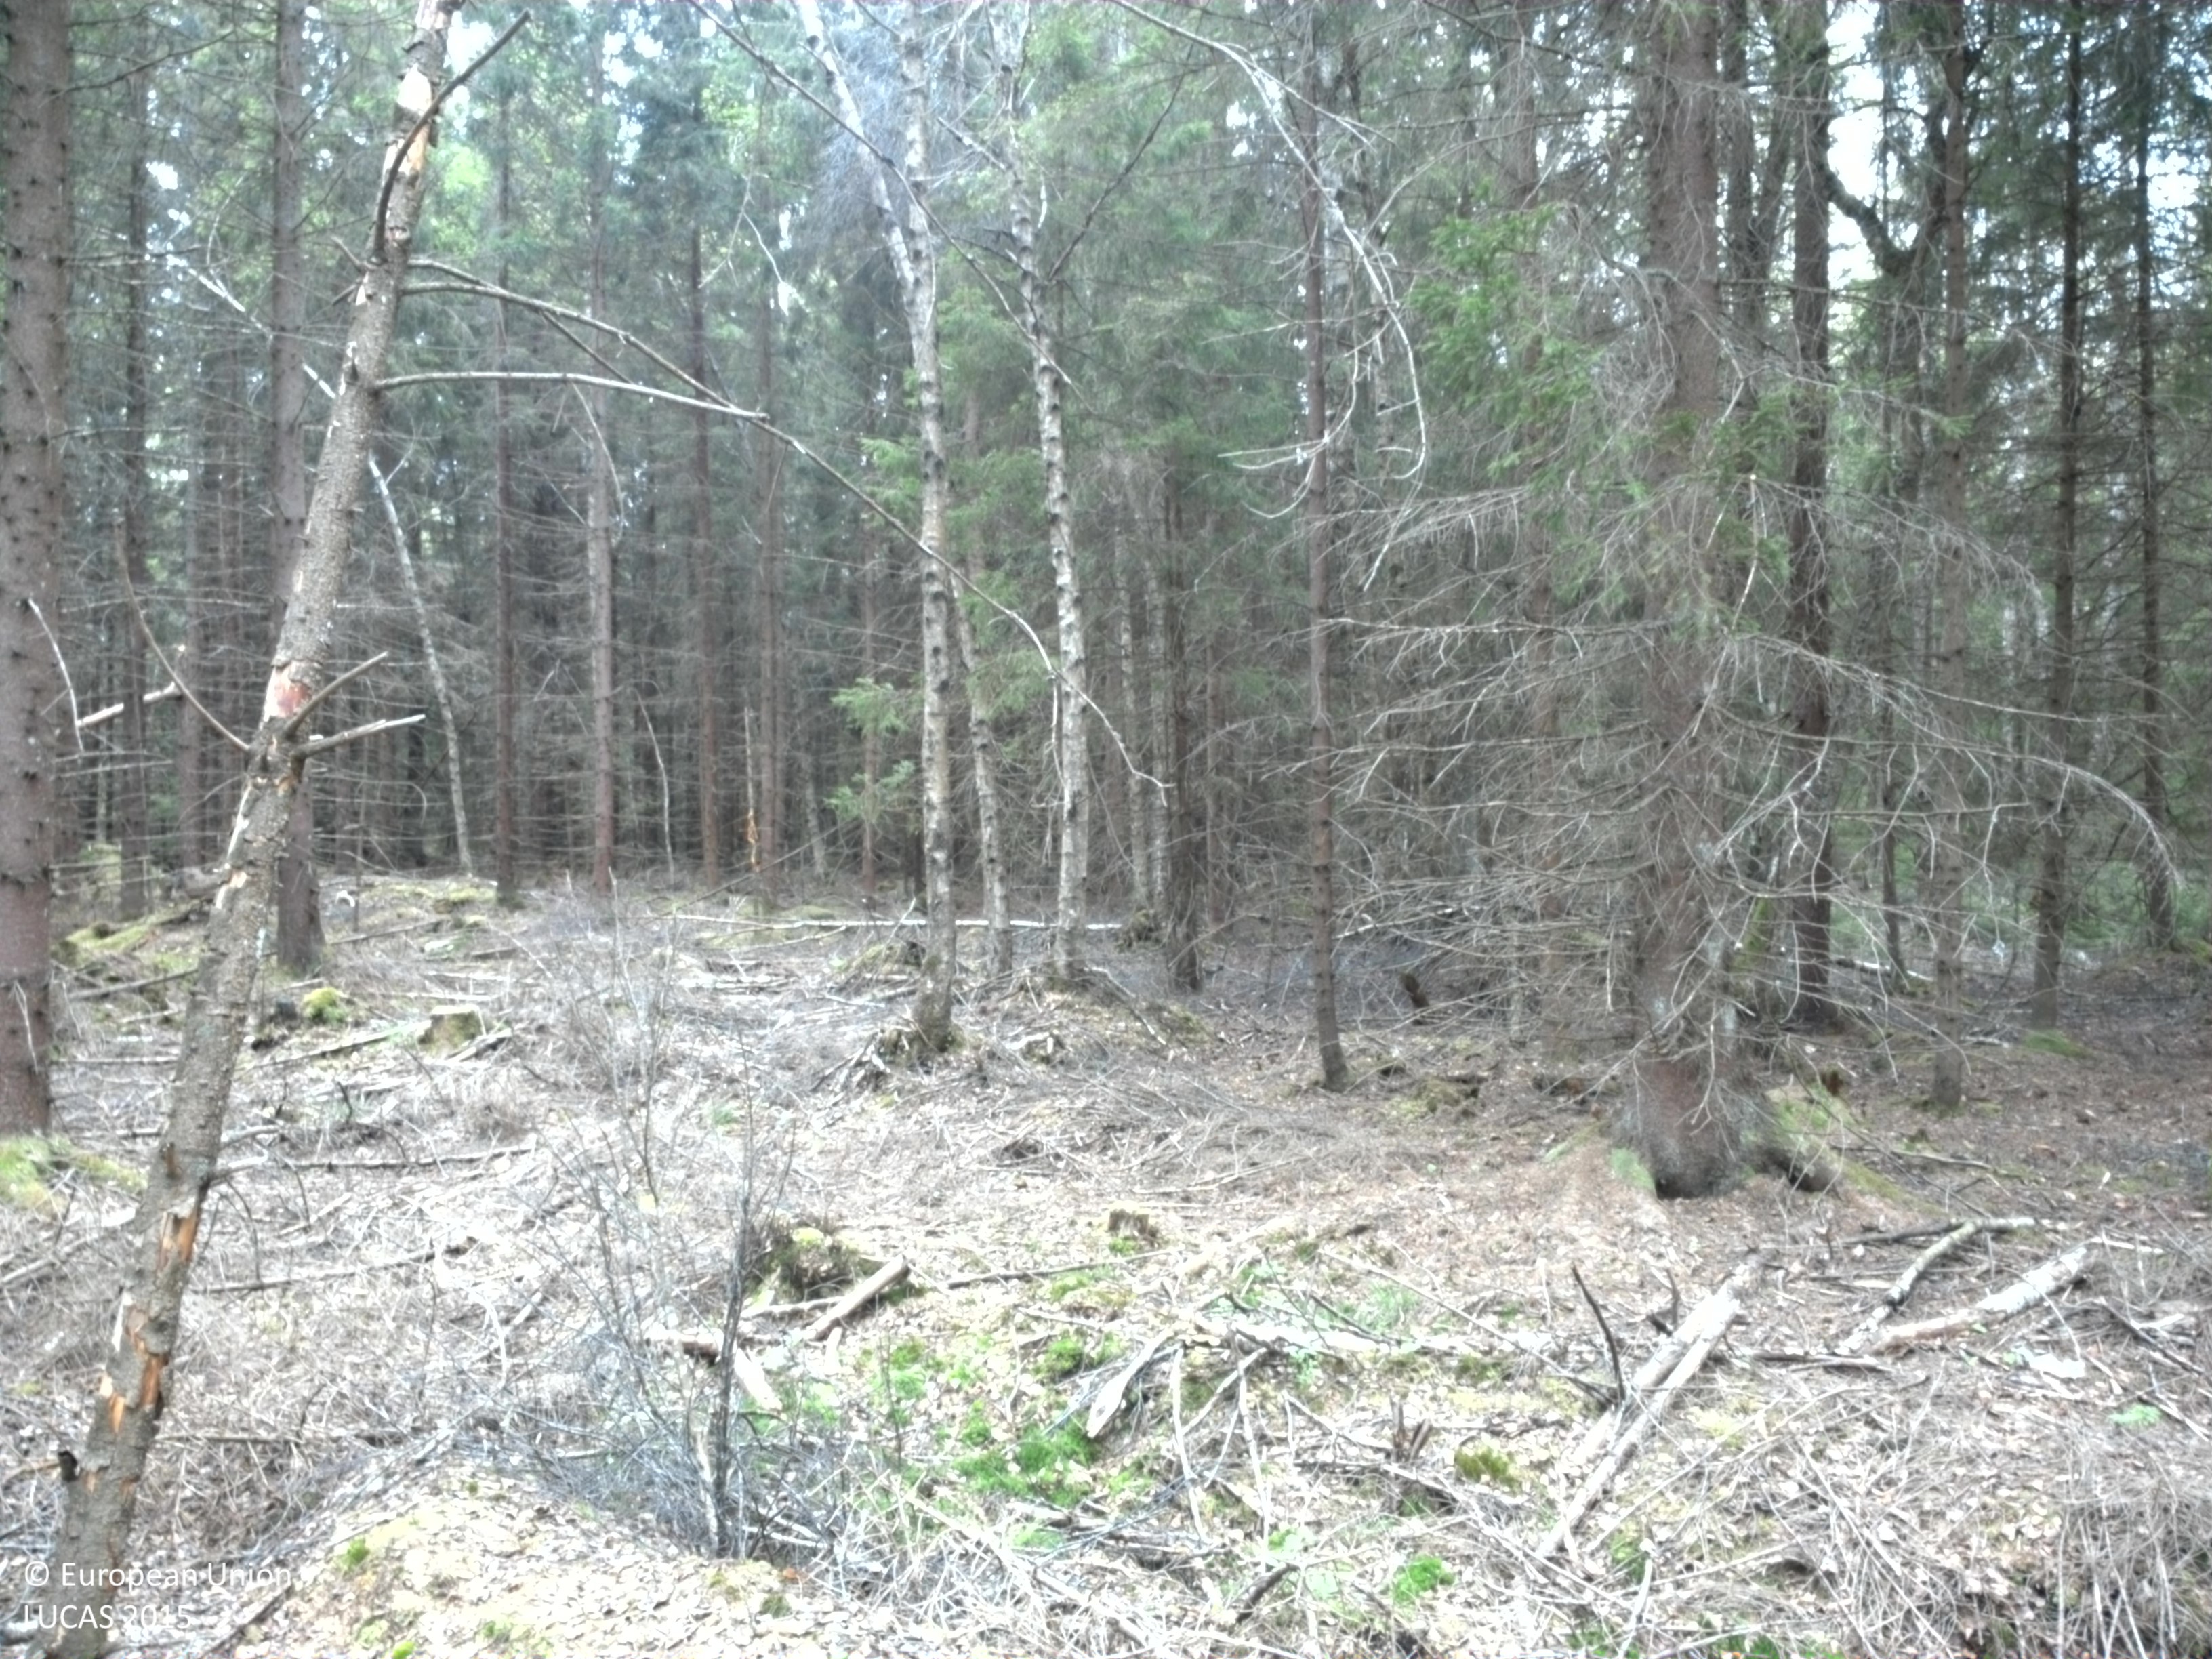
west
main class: Woodland
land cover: Spruce dominated mixed woodland
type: boreal forest
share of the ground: 50 - 75 %
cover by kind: coniferous forest trees 30 %, broadleaved forest trees 30 %, lichens and mosses 30 %, shrubs 10 %
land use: Forestry
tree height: > 5 m
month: May
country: SE
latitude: 56.8548
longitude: 15.2619
